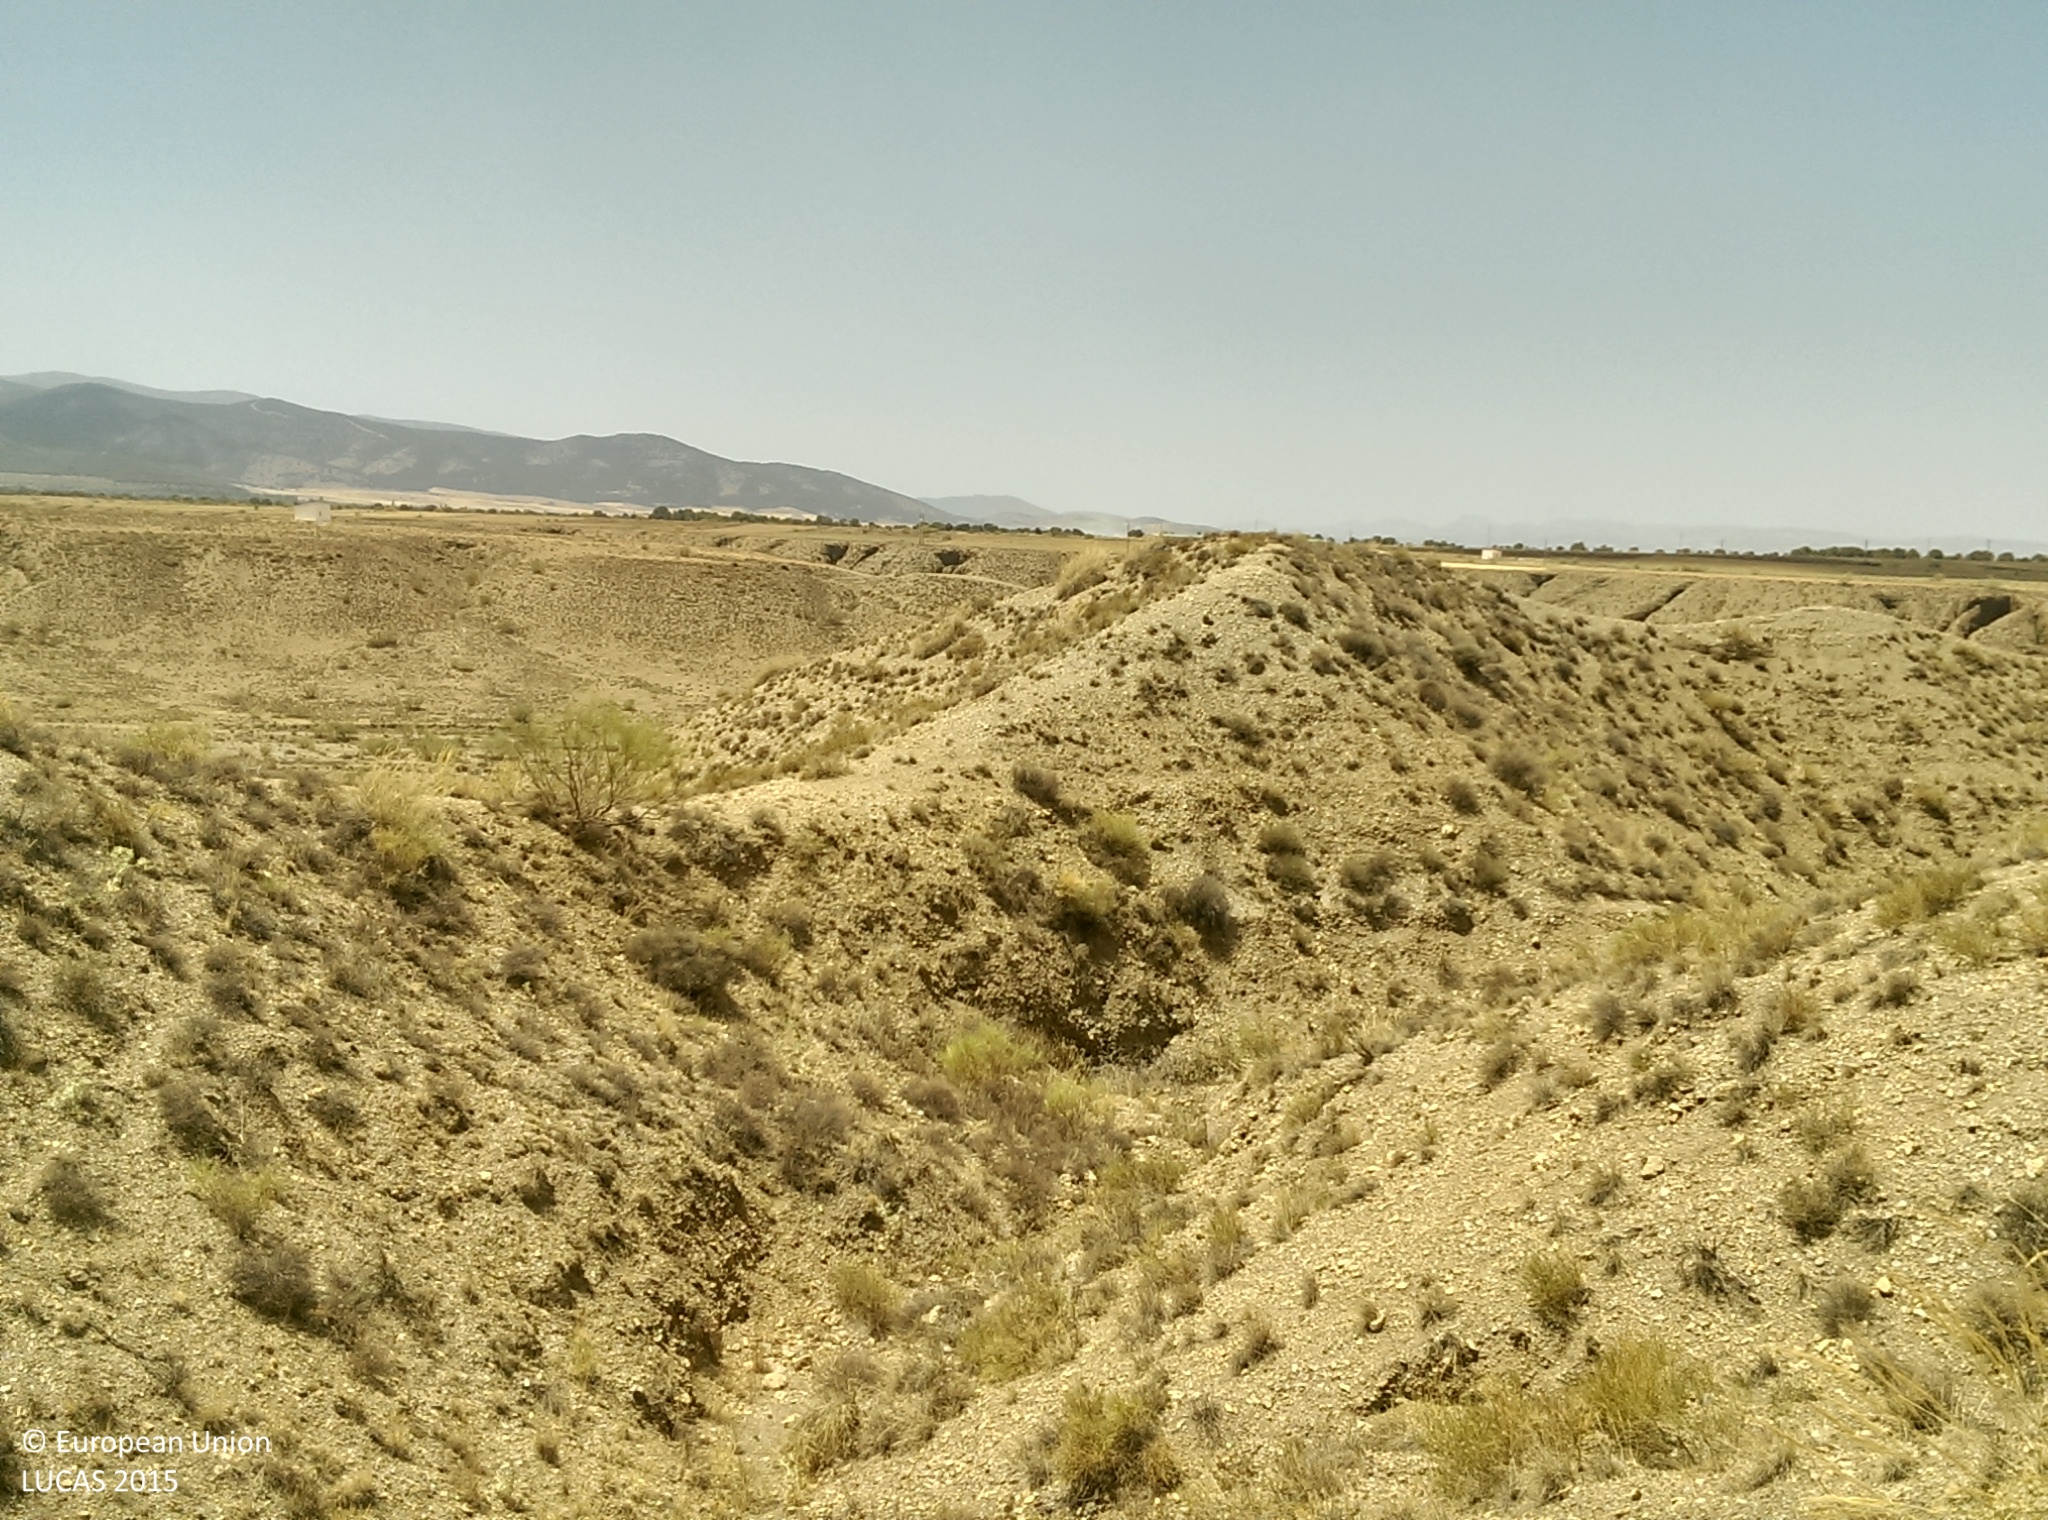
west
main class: Shrubland
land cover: Shrubland without tree cover
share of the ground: 25 - 50 %
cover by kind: shrubs 45 %, unconsolidated bare surface 35 %, herbaceous plants 20 %
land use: Semi-natural and natural areas not in use
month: July
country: ES
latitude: 37.2234
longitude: -3.0926
